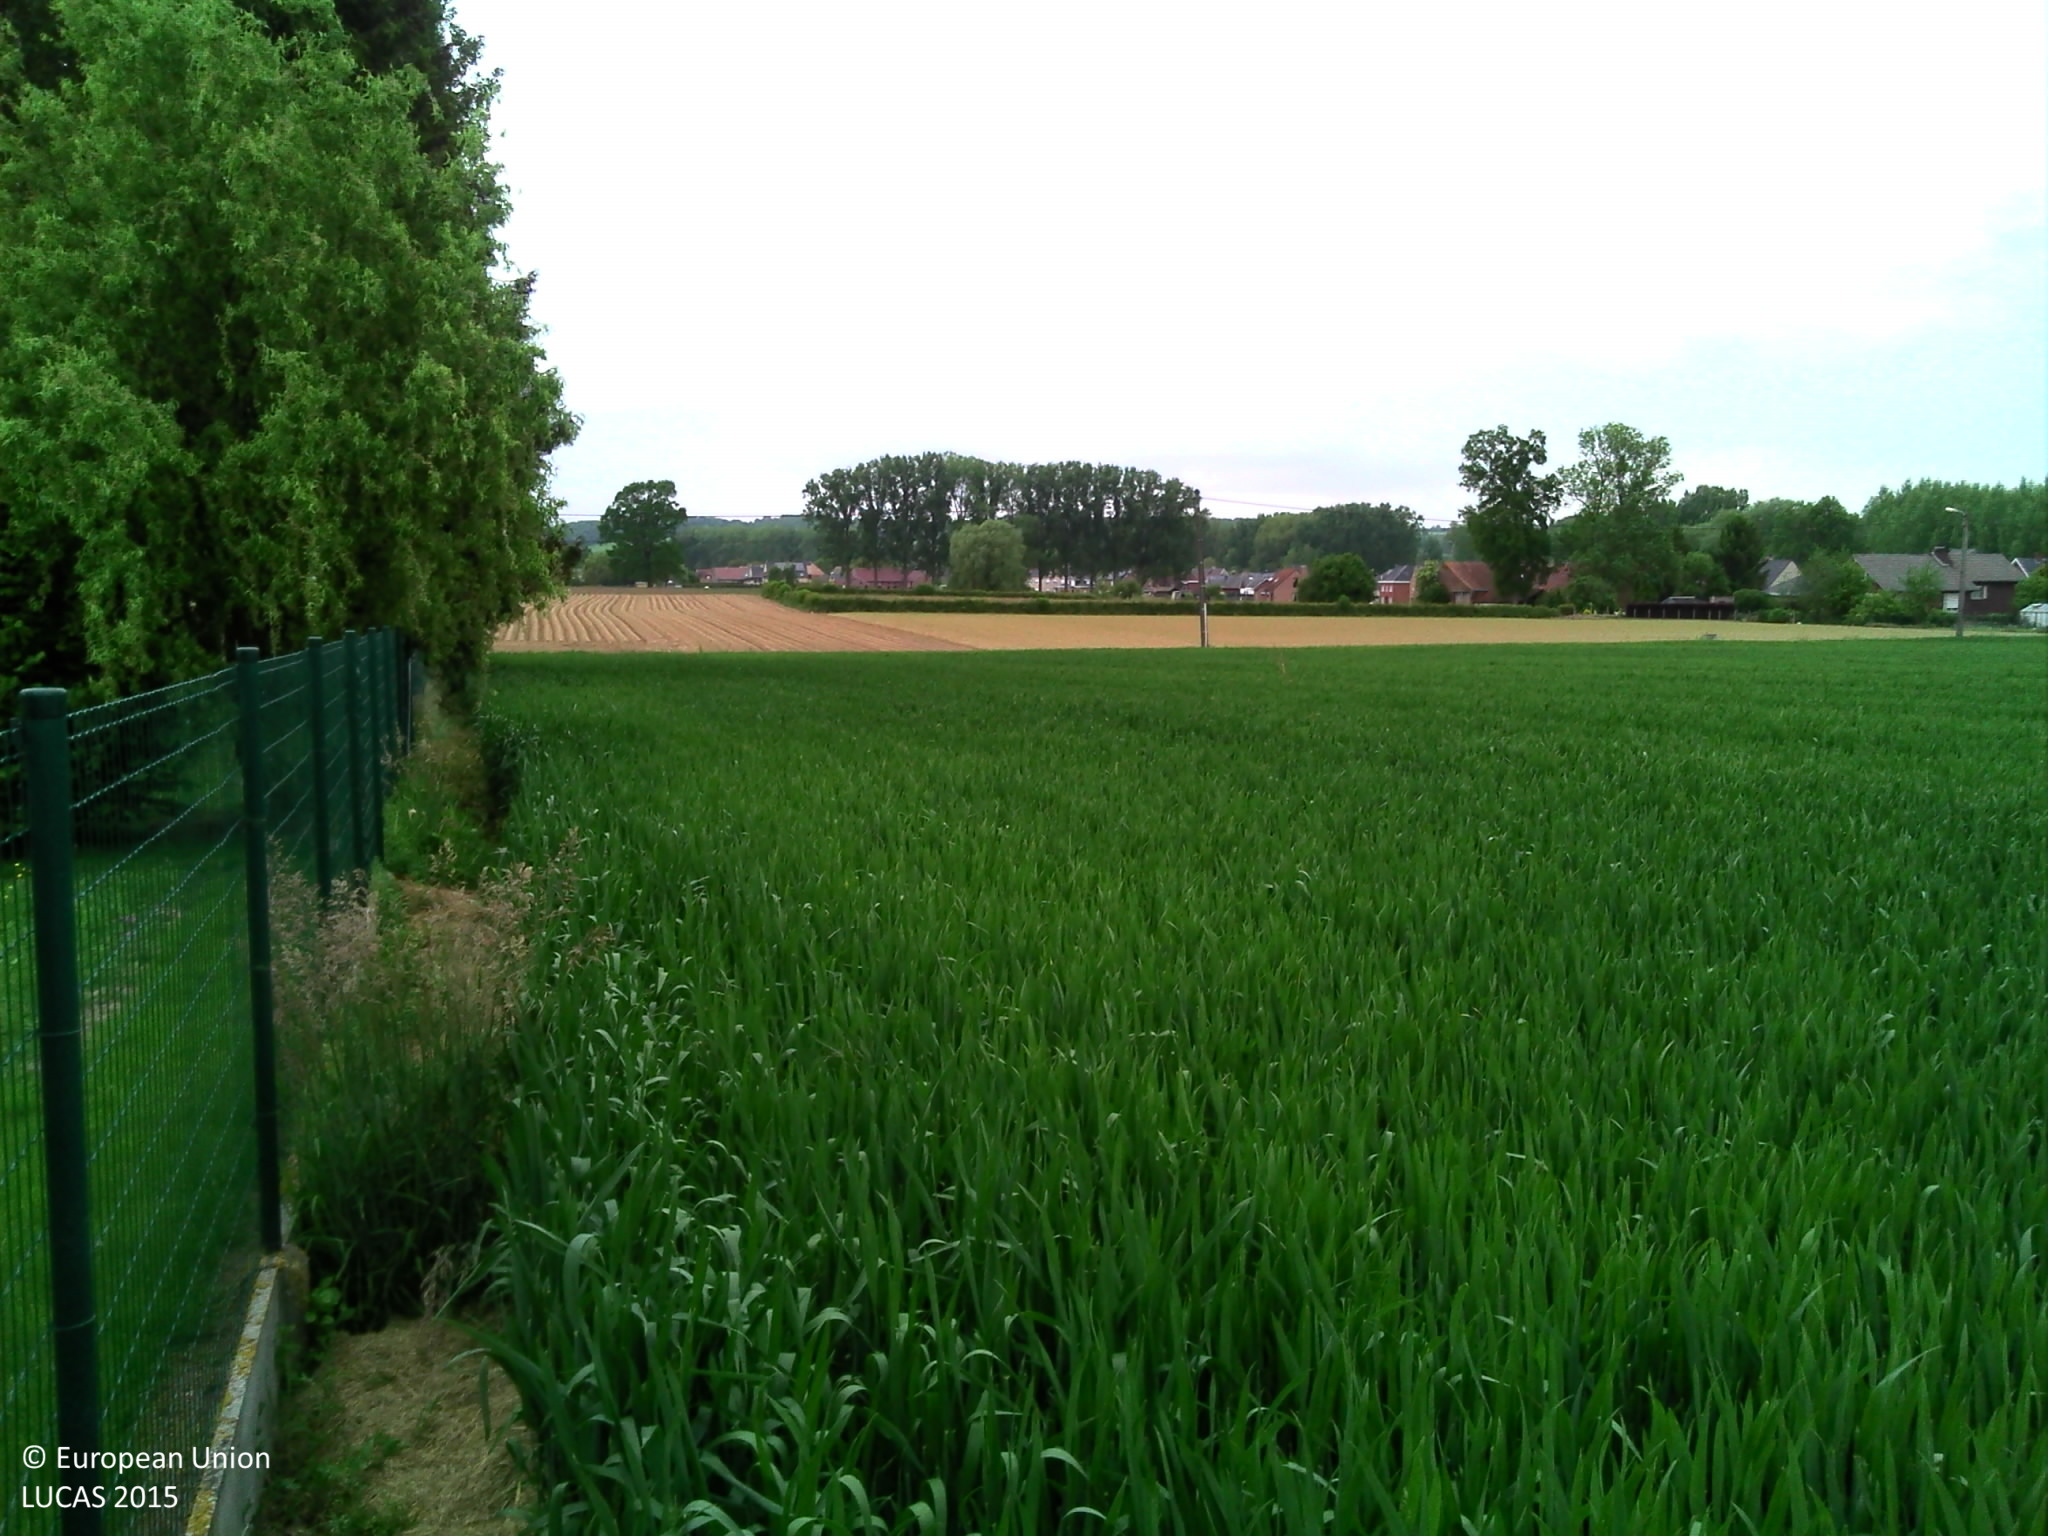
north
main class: Grassland
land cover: Grassland without tree/shrub cover
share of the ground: > 75 %
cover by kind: herbaceous plants 95 %, shrubs 5 %
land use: Residential
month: May
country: BE
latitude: 50.7460
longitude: 3.9708
